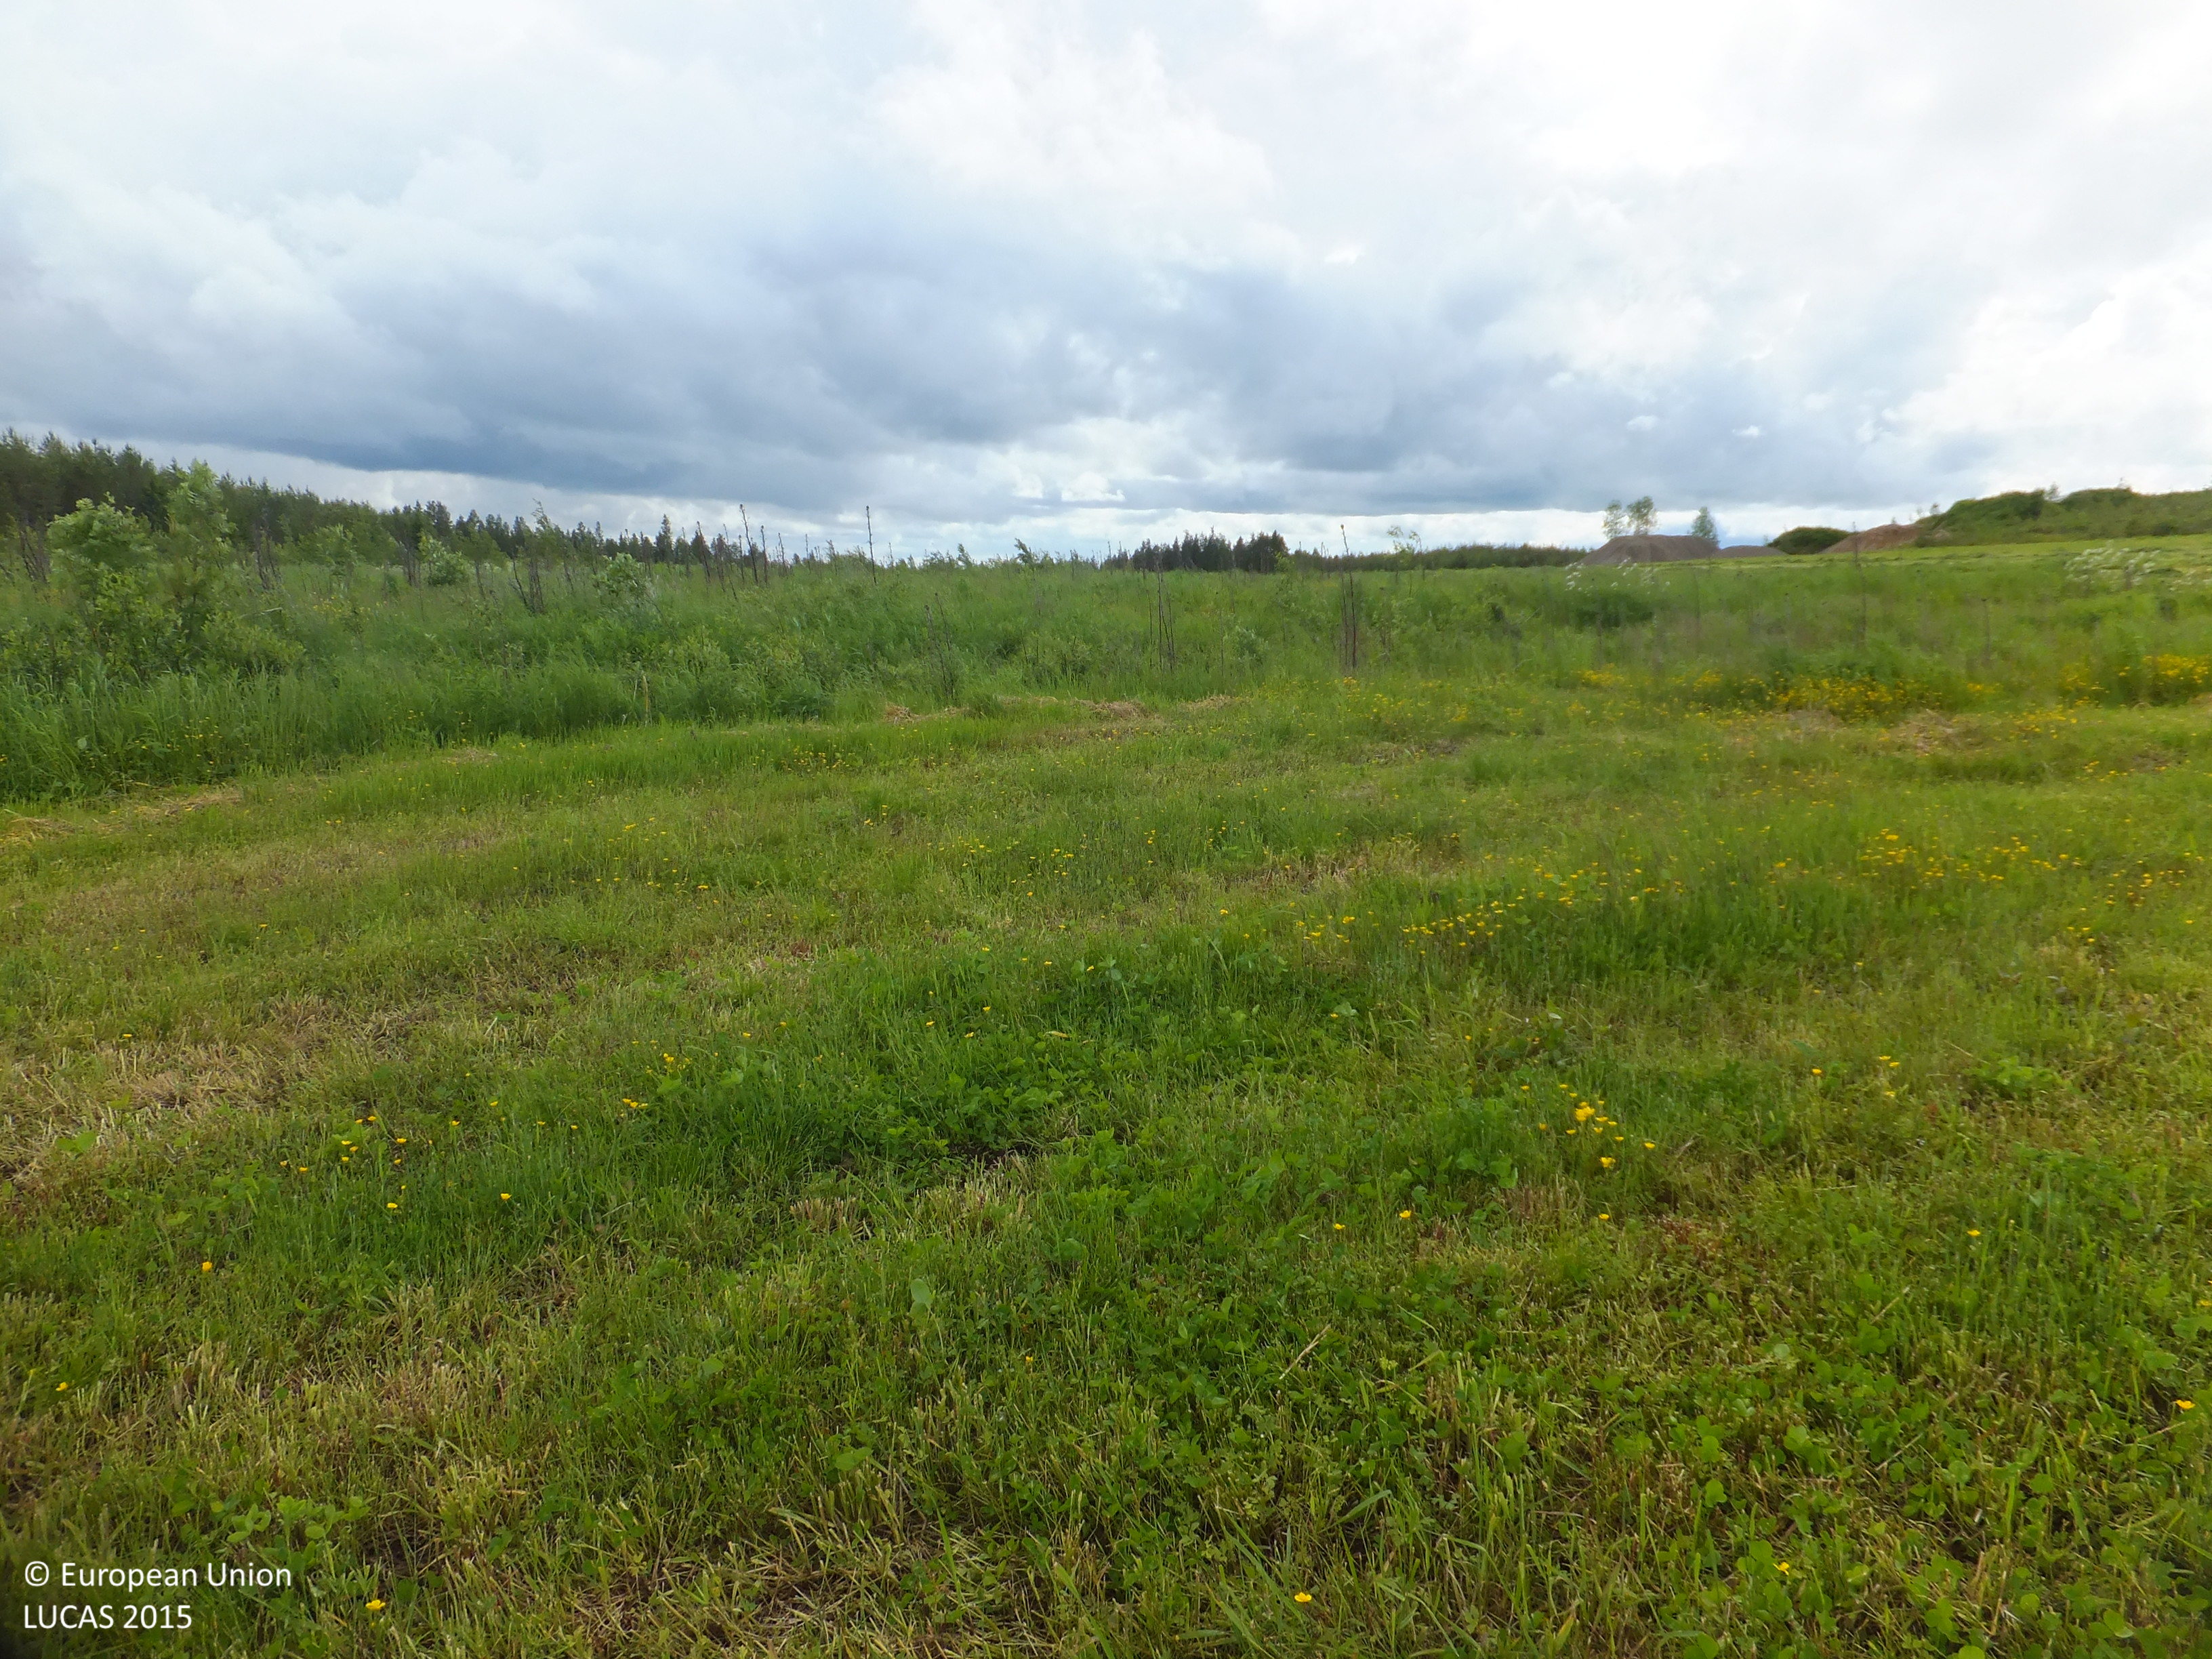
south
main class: Grassland
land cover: Grassland without tree/shrub cover
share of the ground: > 75 %
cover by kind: herbaceous plants 100 %
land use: Agriculture (excluding fallow land and kitchen gardens)
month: June
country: FI
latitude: 63.3259
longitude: 23.8667
